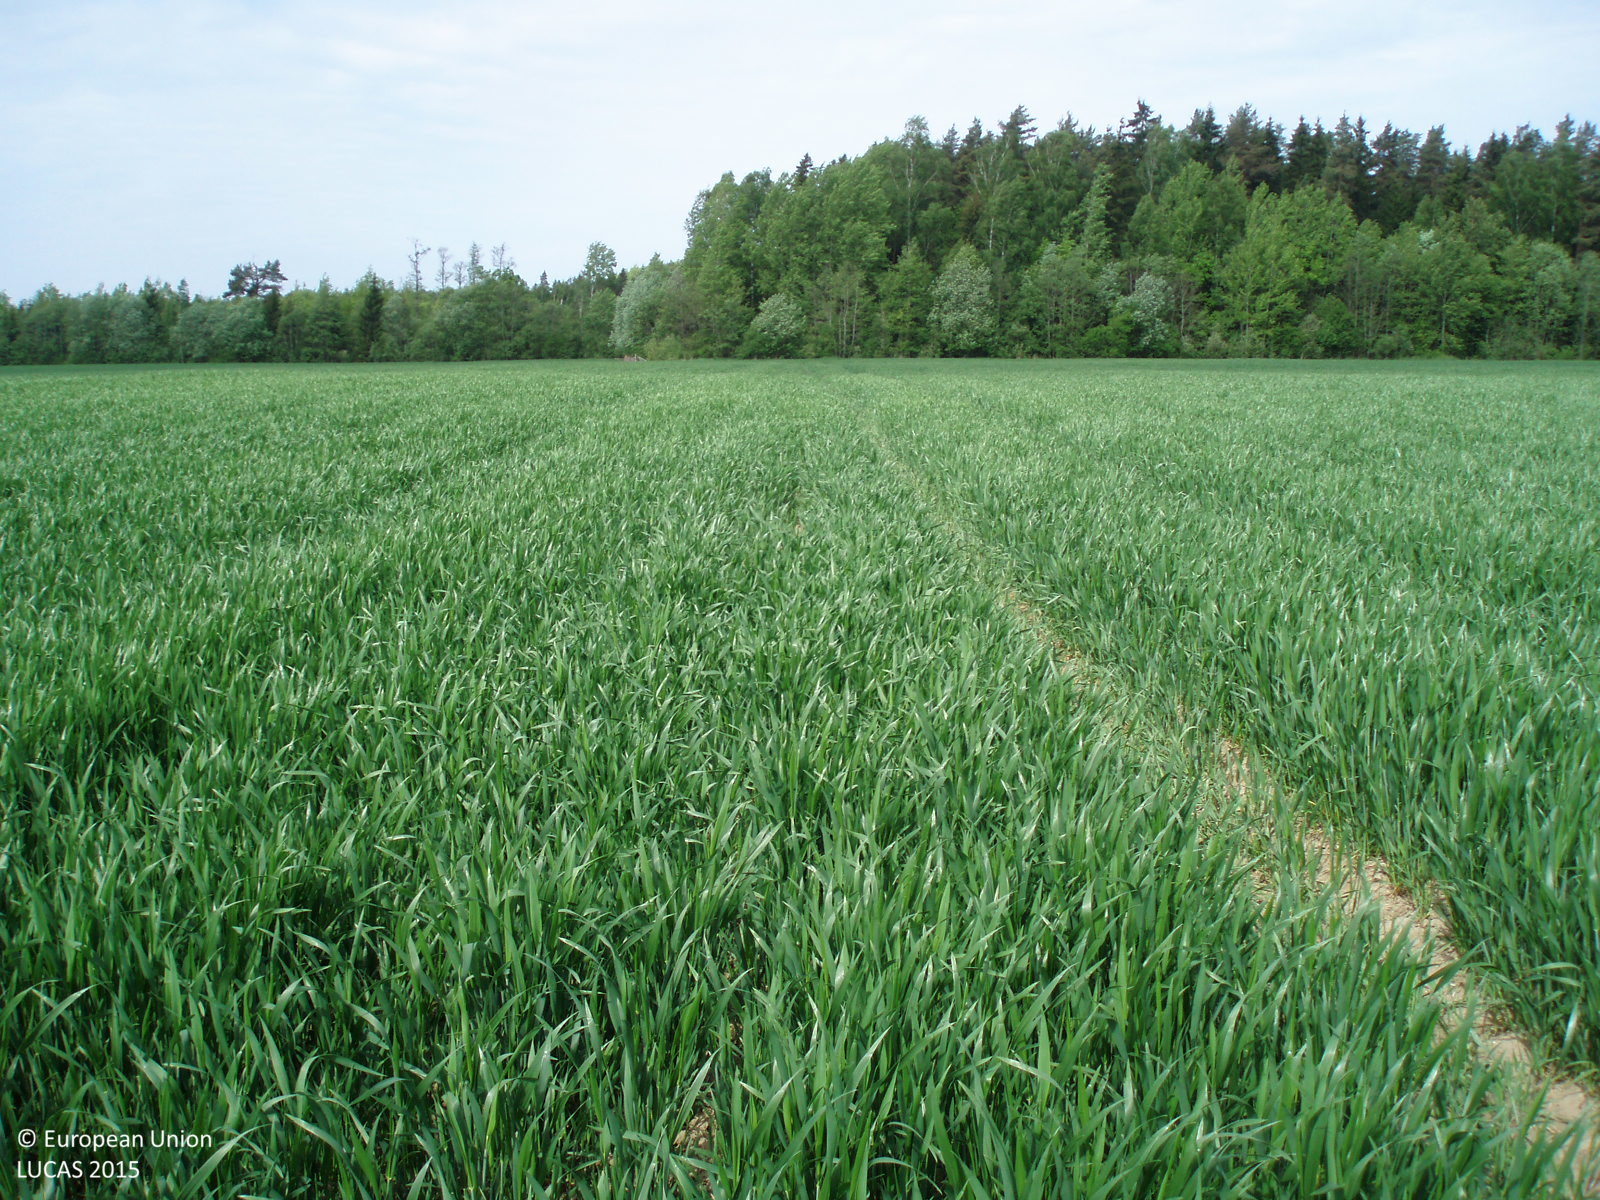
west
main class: Cropland
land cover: Common wheat
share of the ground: > 75 %
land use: Agriculture (excluding fallow land and kitchen gardens)
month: May
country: LT
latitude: 56.1831
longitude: 22.4143
